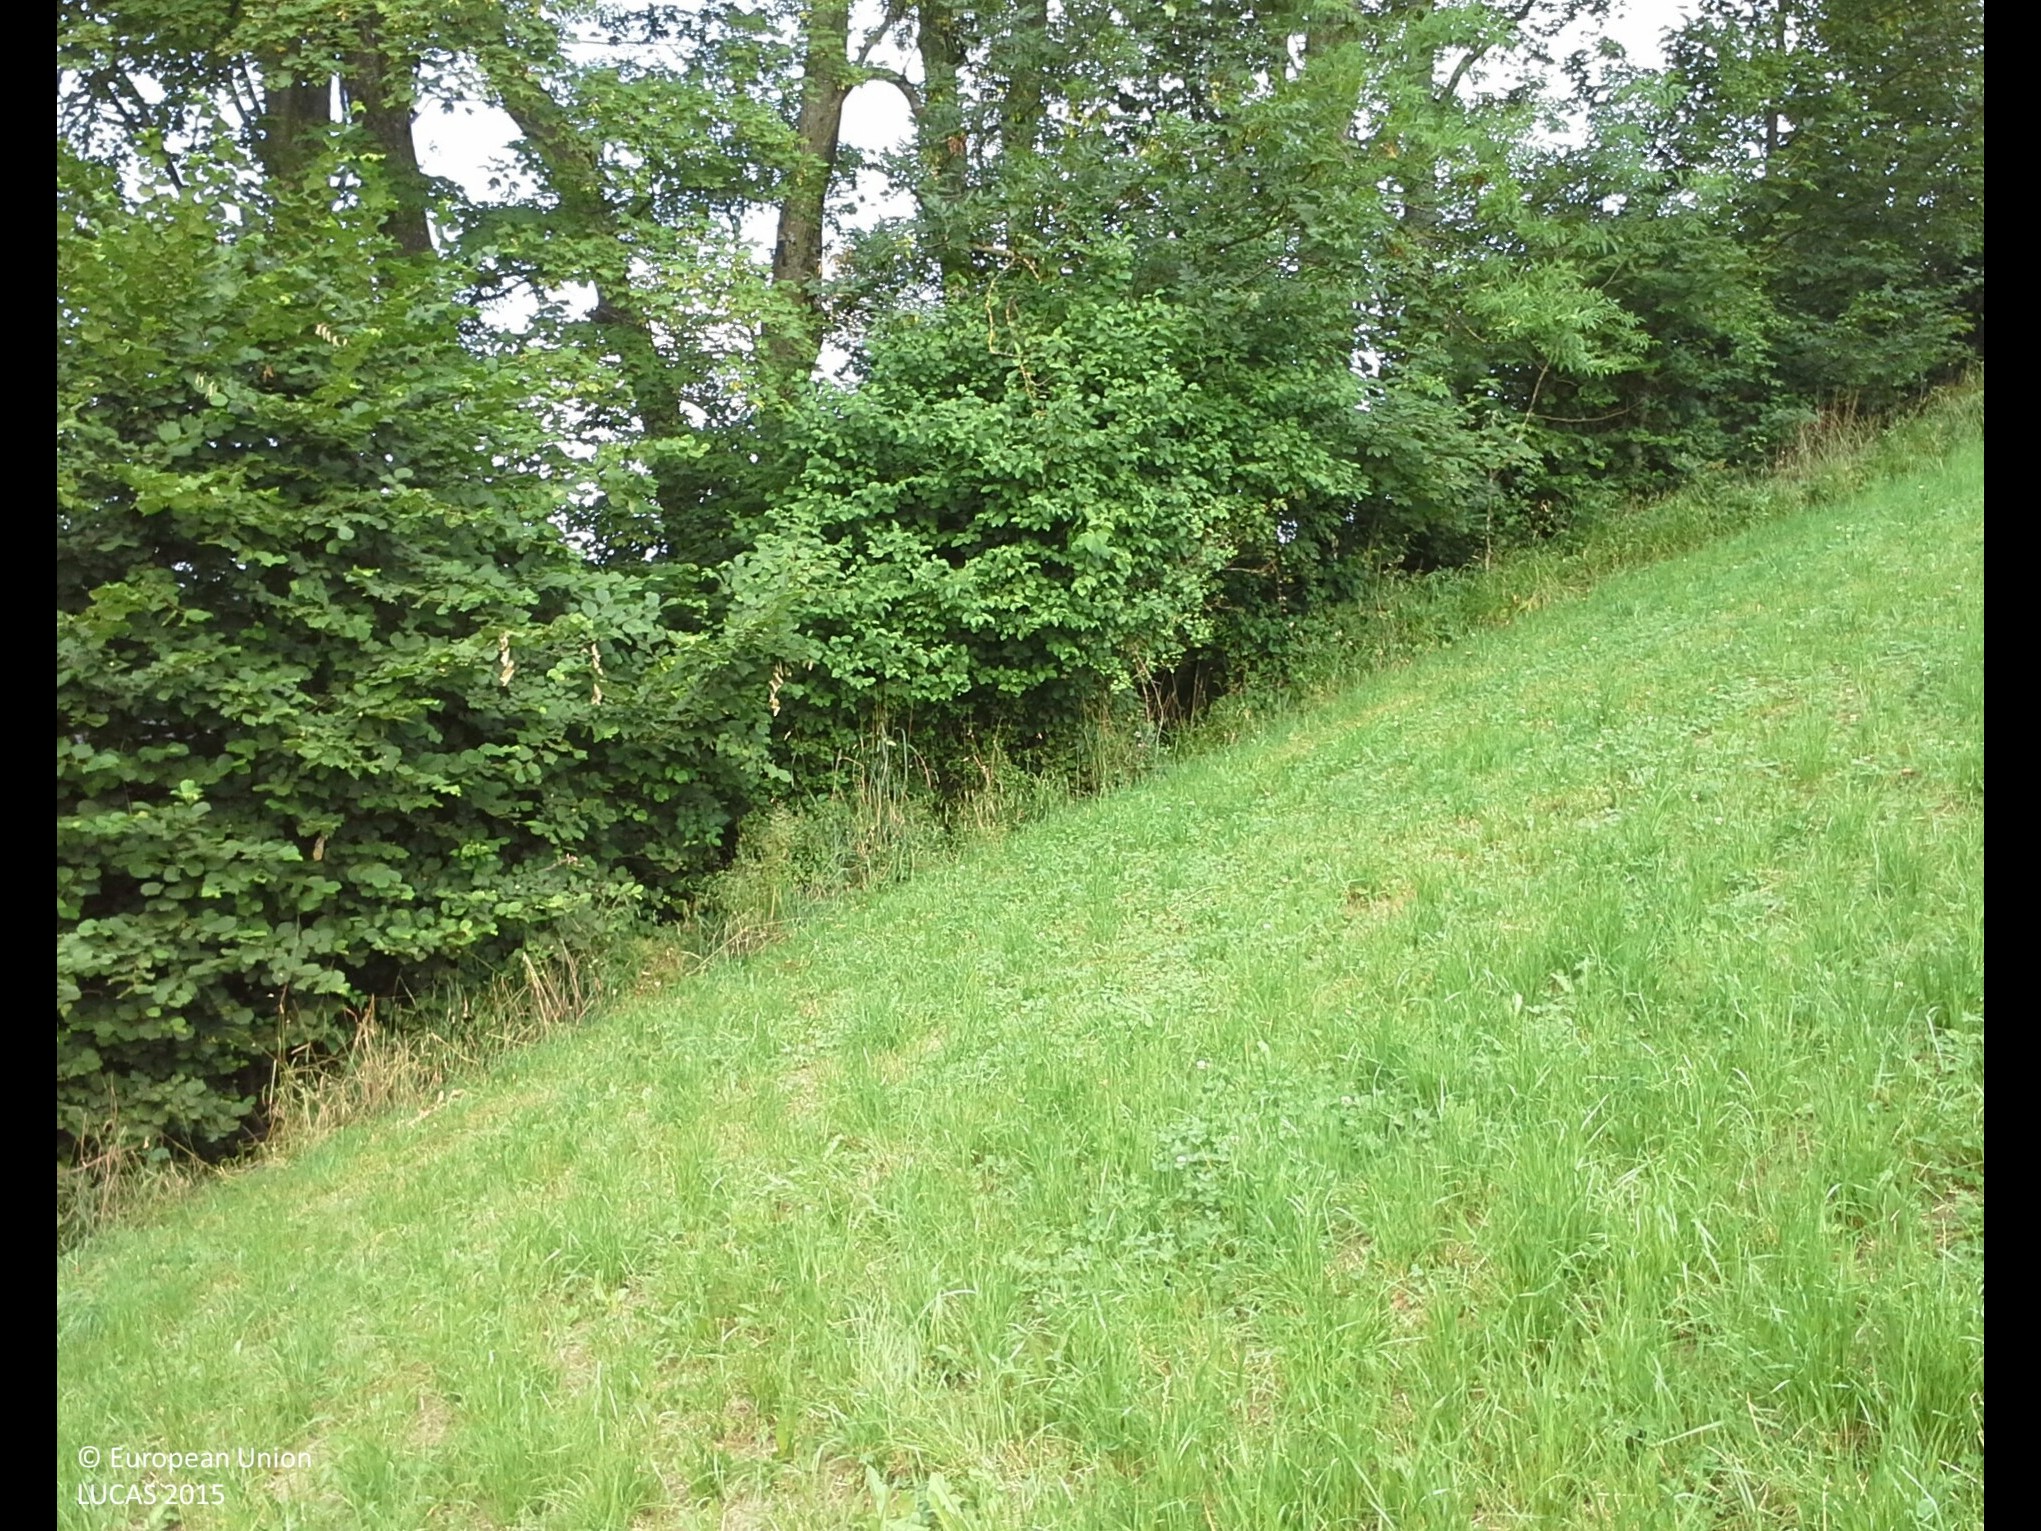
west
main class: Grassland
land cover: Grassland without tree/shrub cover
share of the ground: > 75 %
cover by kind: herbaceous plants 100 %
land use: Agriculture (excluding fallow land and kitchen gardens)
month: July
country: AT
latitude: 48.0026
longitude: 14.5706
